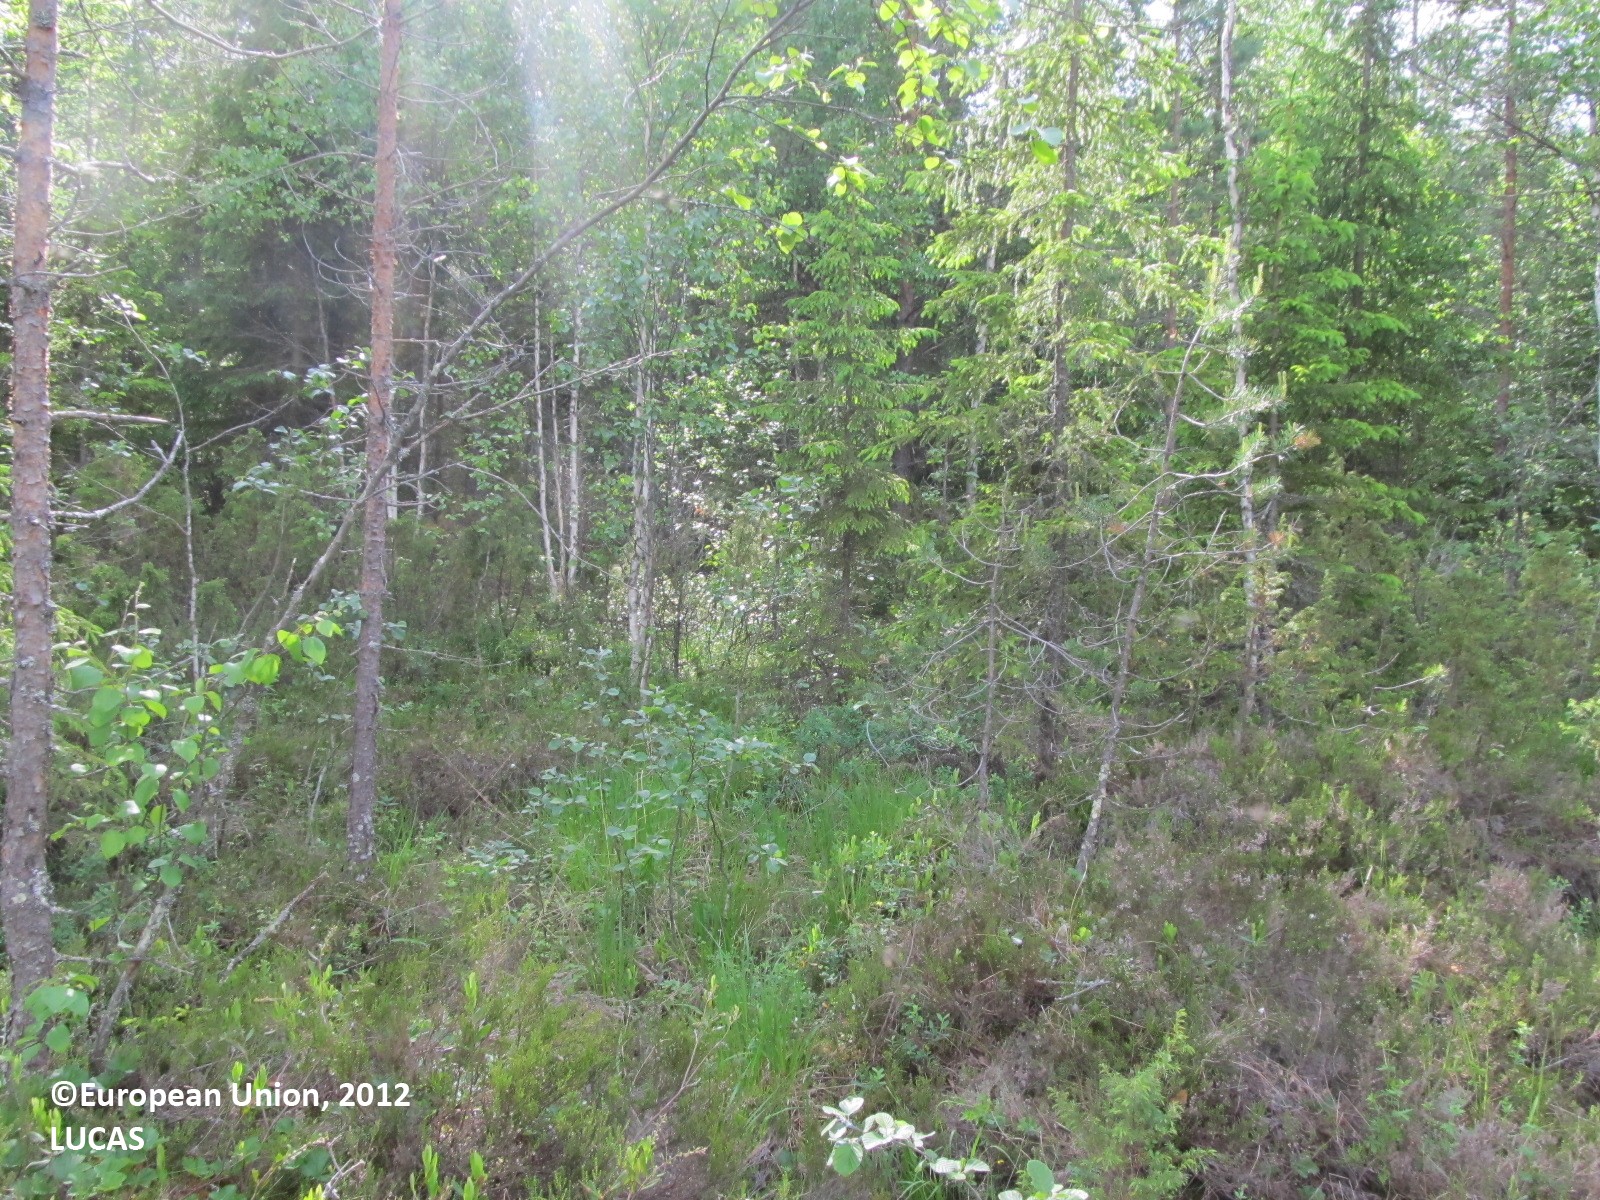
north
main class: Woodland
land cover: Pine dominated mixed woodland
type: boreal forest
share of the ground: 50 - 75 %
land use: Semi-natural and natural areas not in use
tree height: > 5 m
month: June
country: FI
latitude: 62.9563
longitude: 28.9612
